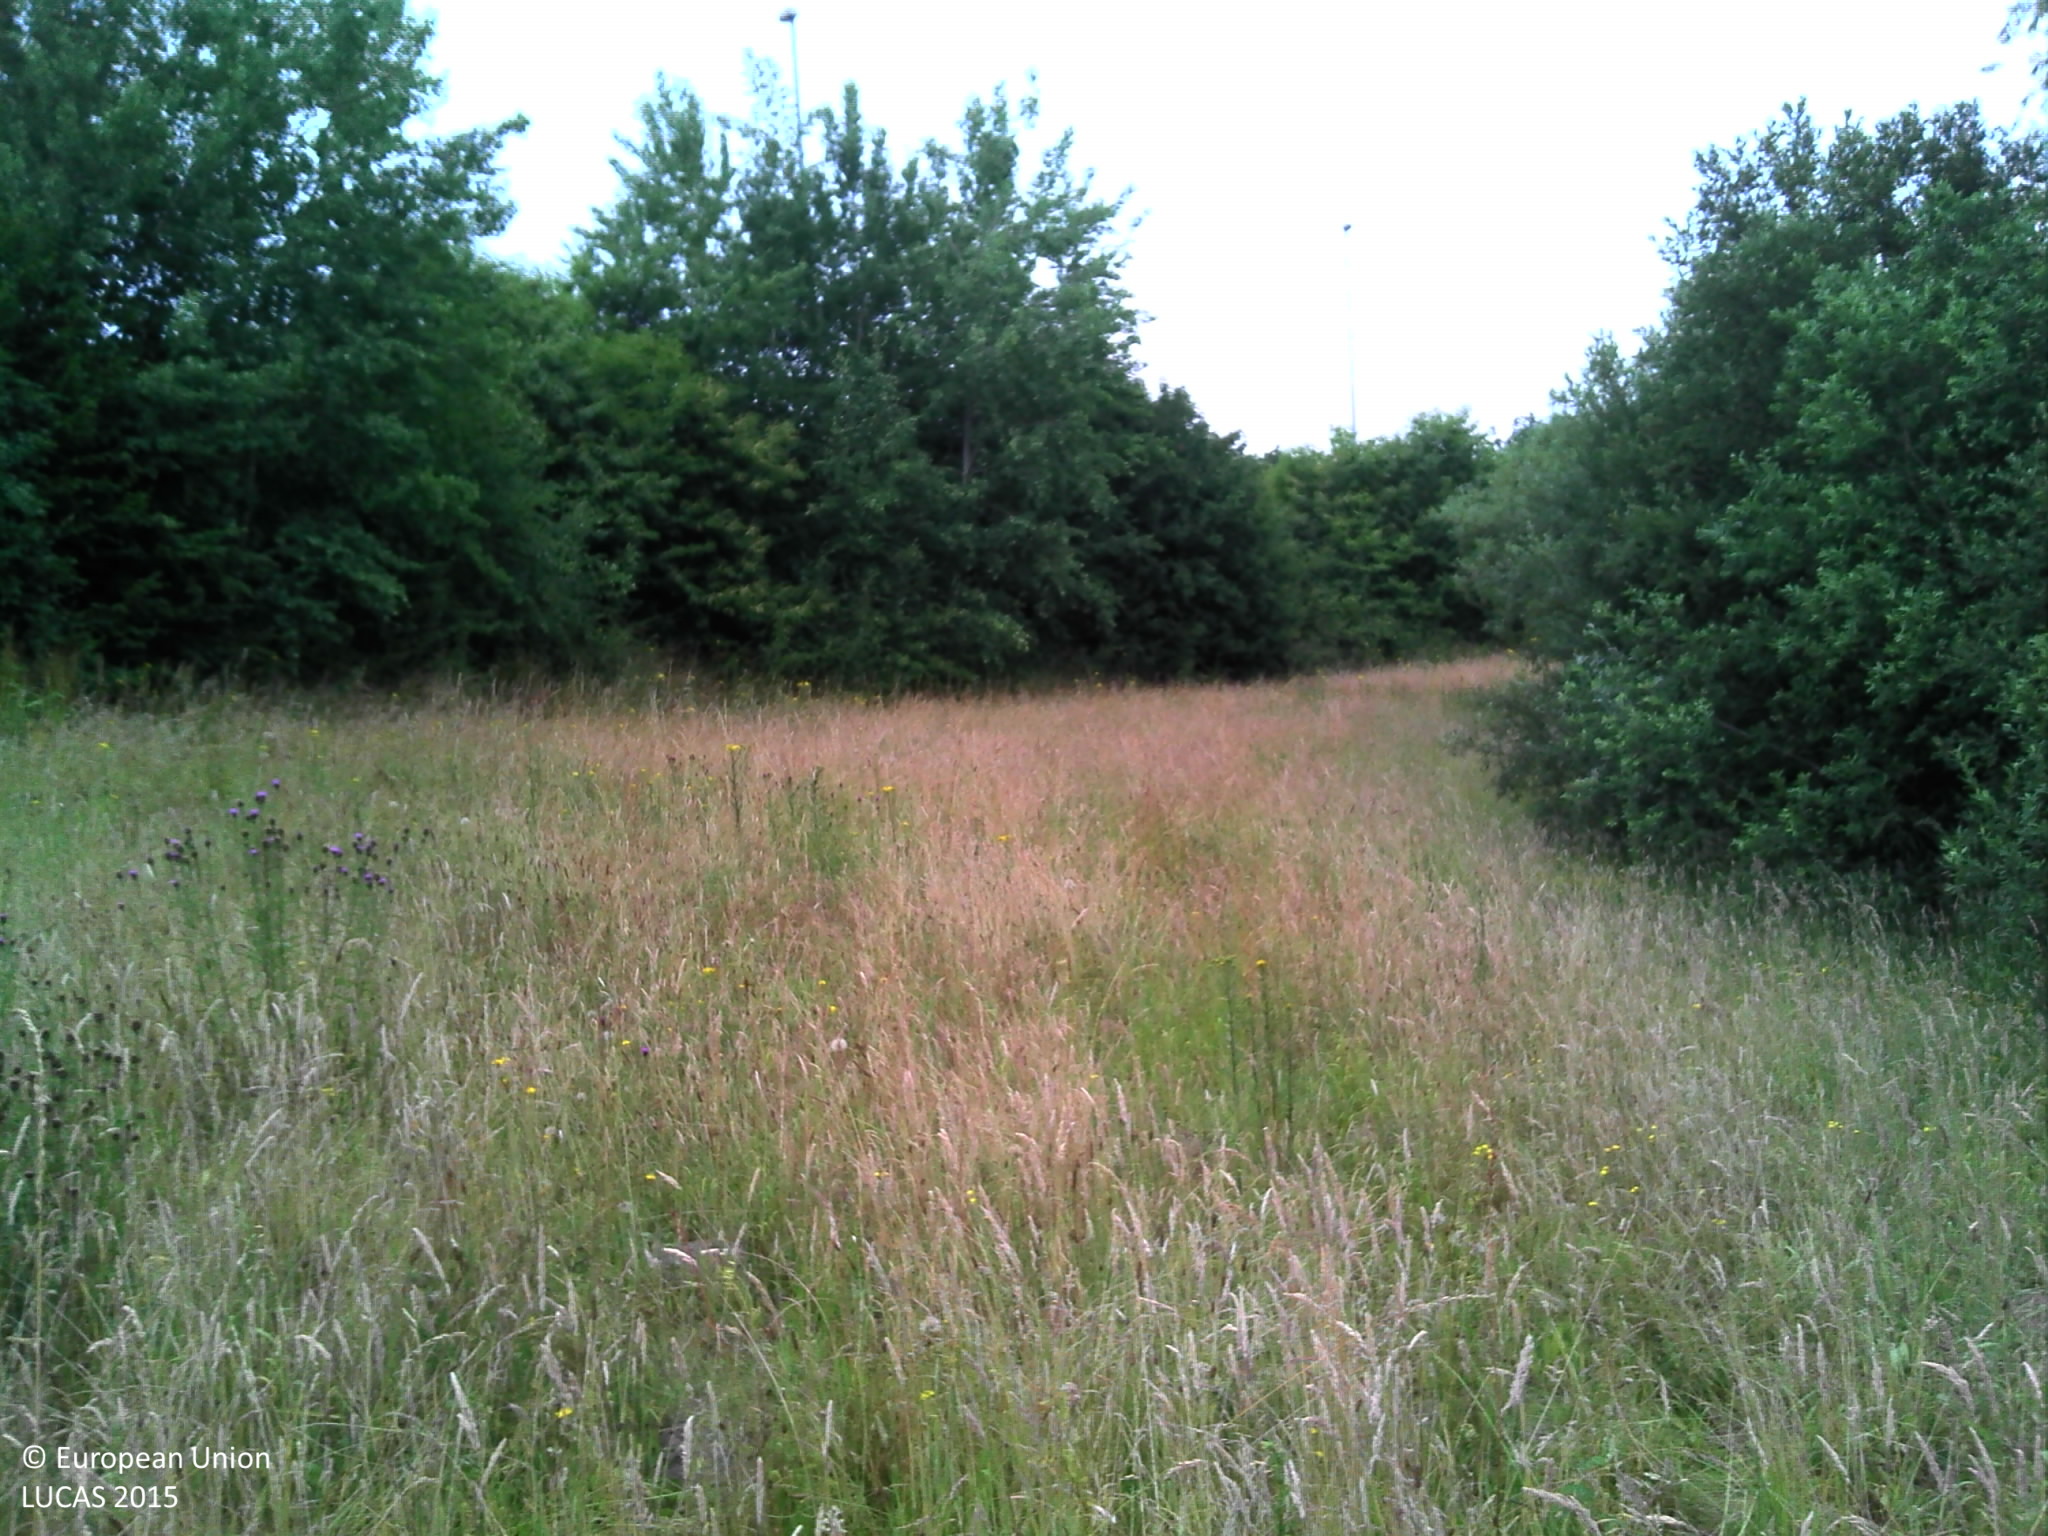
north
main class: Grassland
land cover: Spontaneously vegetated surfaces
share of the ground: > 75 %
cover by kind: herbaceous plants 100 %
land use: Semi-natural and natural areas not in use
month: July
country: BE
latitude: 51.2094
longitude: 3.5365
